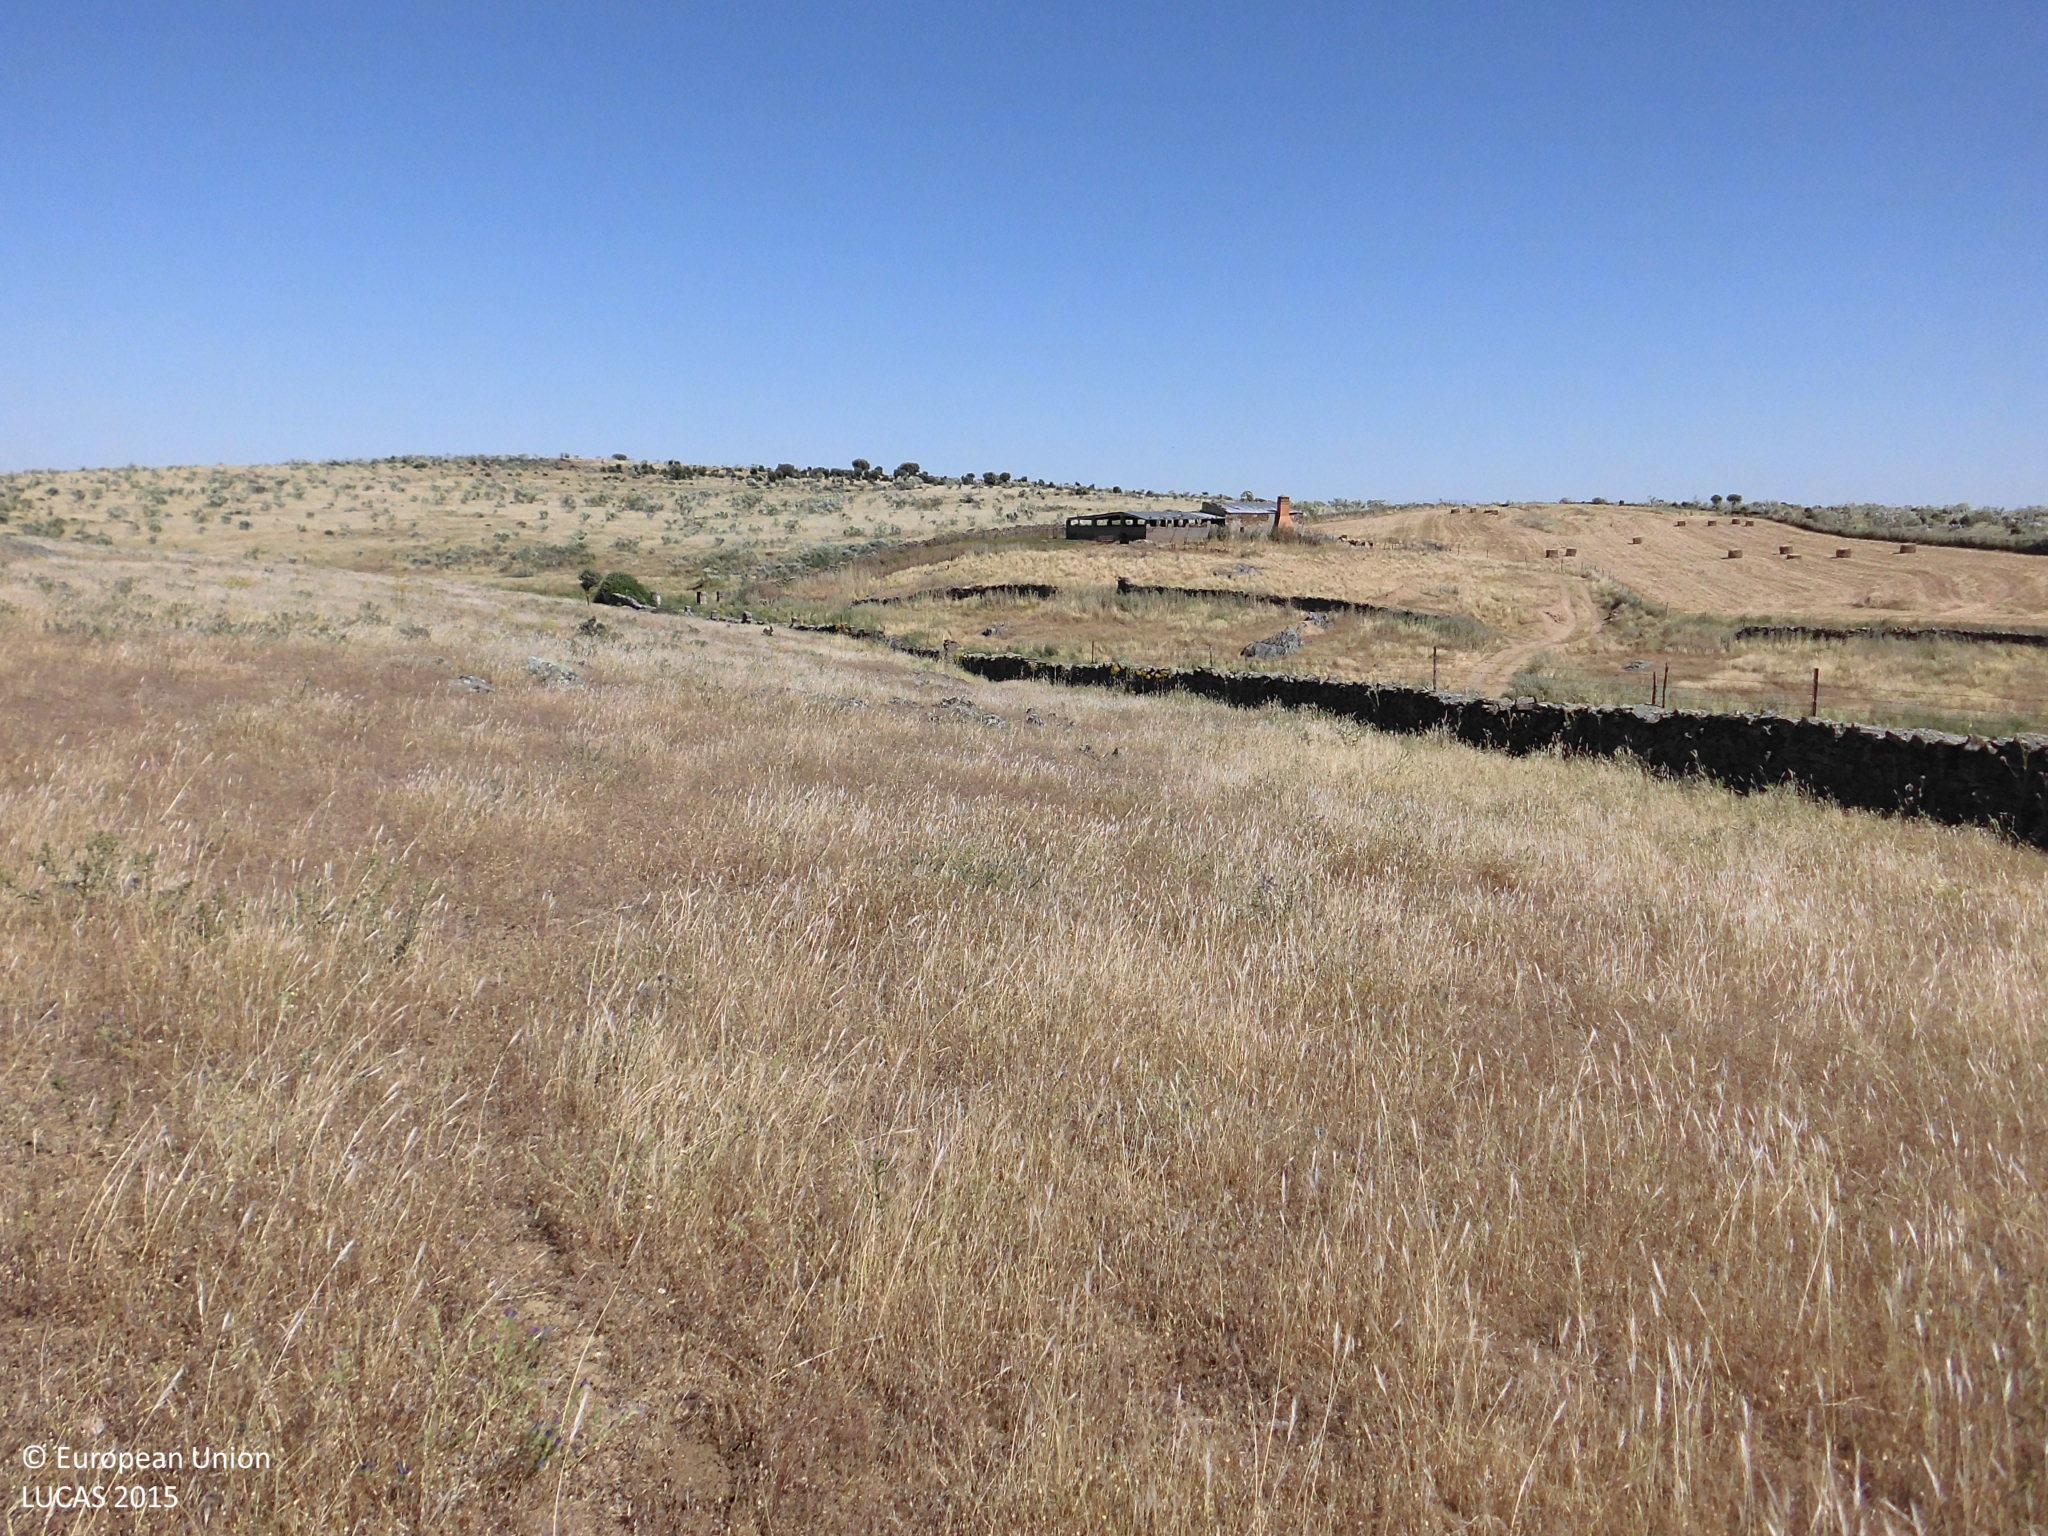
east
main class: Grassland
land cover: Grassland without tree/shrub cover
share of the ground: > 75 %
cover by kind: herbaceous plants 100 %
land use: Agriculture (excluding fallow land and kitchen gardens)
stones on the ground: 10 - 25 %
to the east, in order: Grassland without tree/shrub cover; Fences; Rivers and streams; Shrubland without tree cover
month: May
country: ES
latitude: 39.3750
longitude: -6.0680
